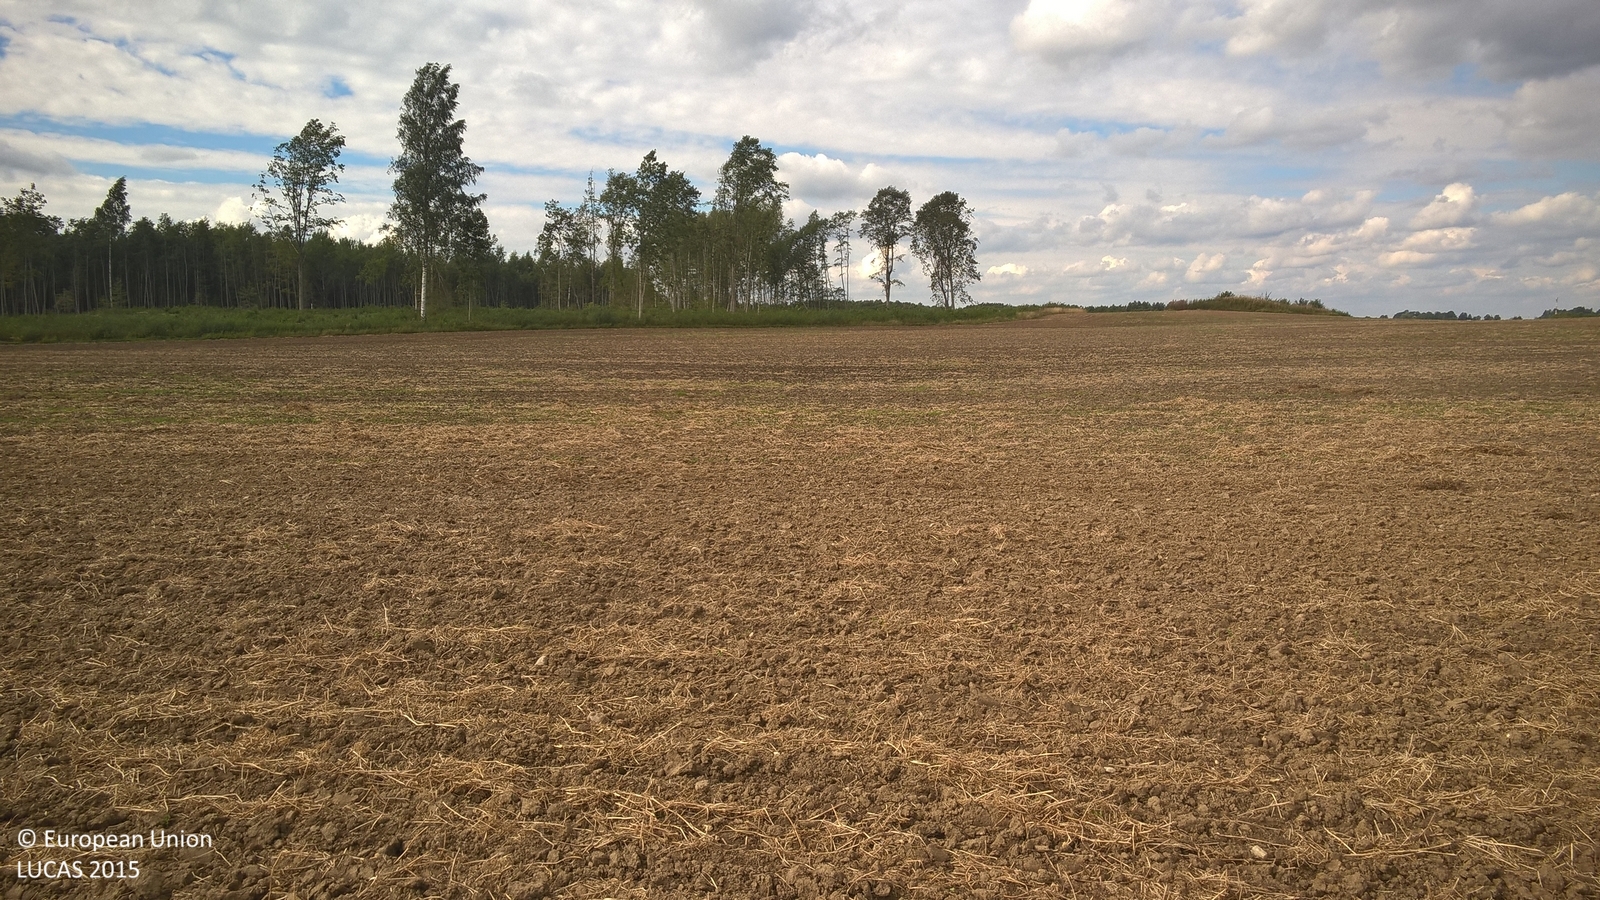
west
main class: Cropland
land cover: Dry pulses
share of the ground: < 10 %
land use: Agriculture (excluding fallow land and kitchen gardens)
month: September
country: LV
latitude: 57.3248
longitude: 25.5458
